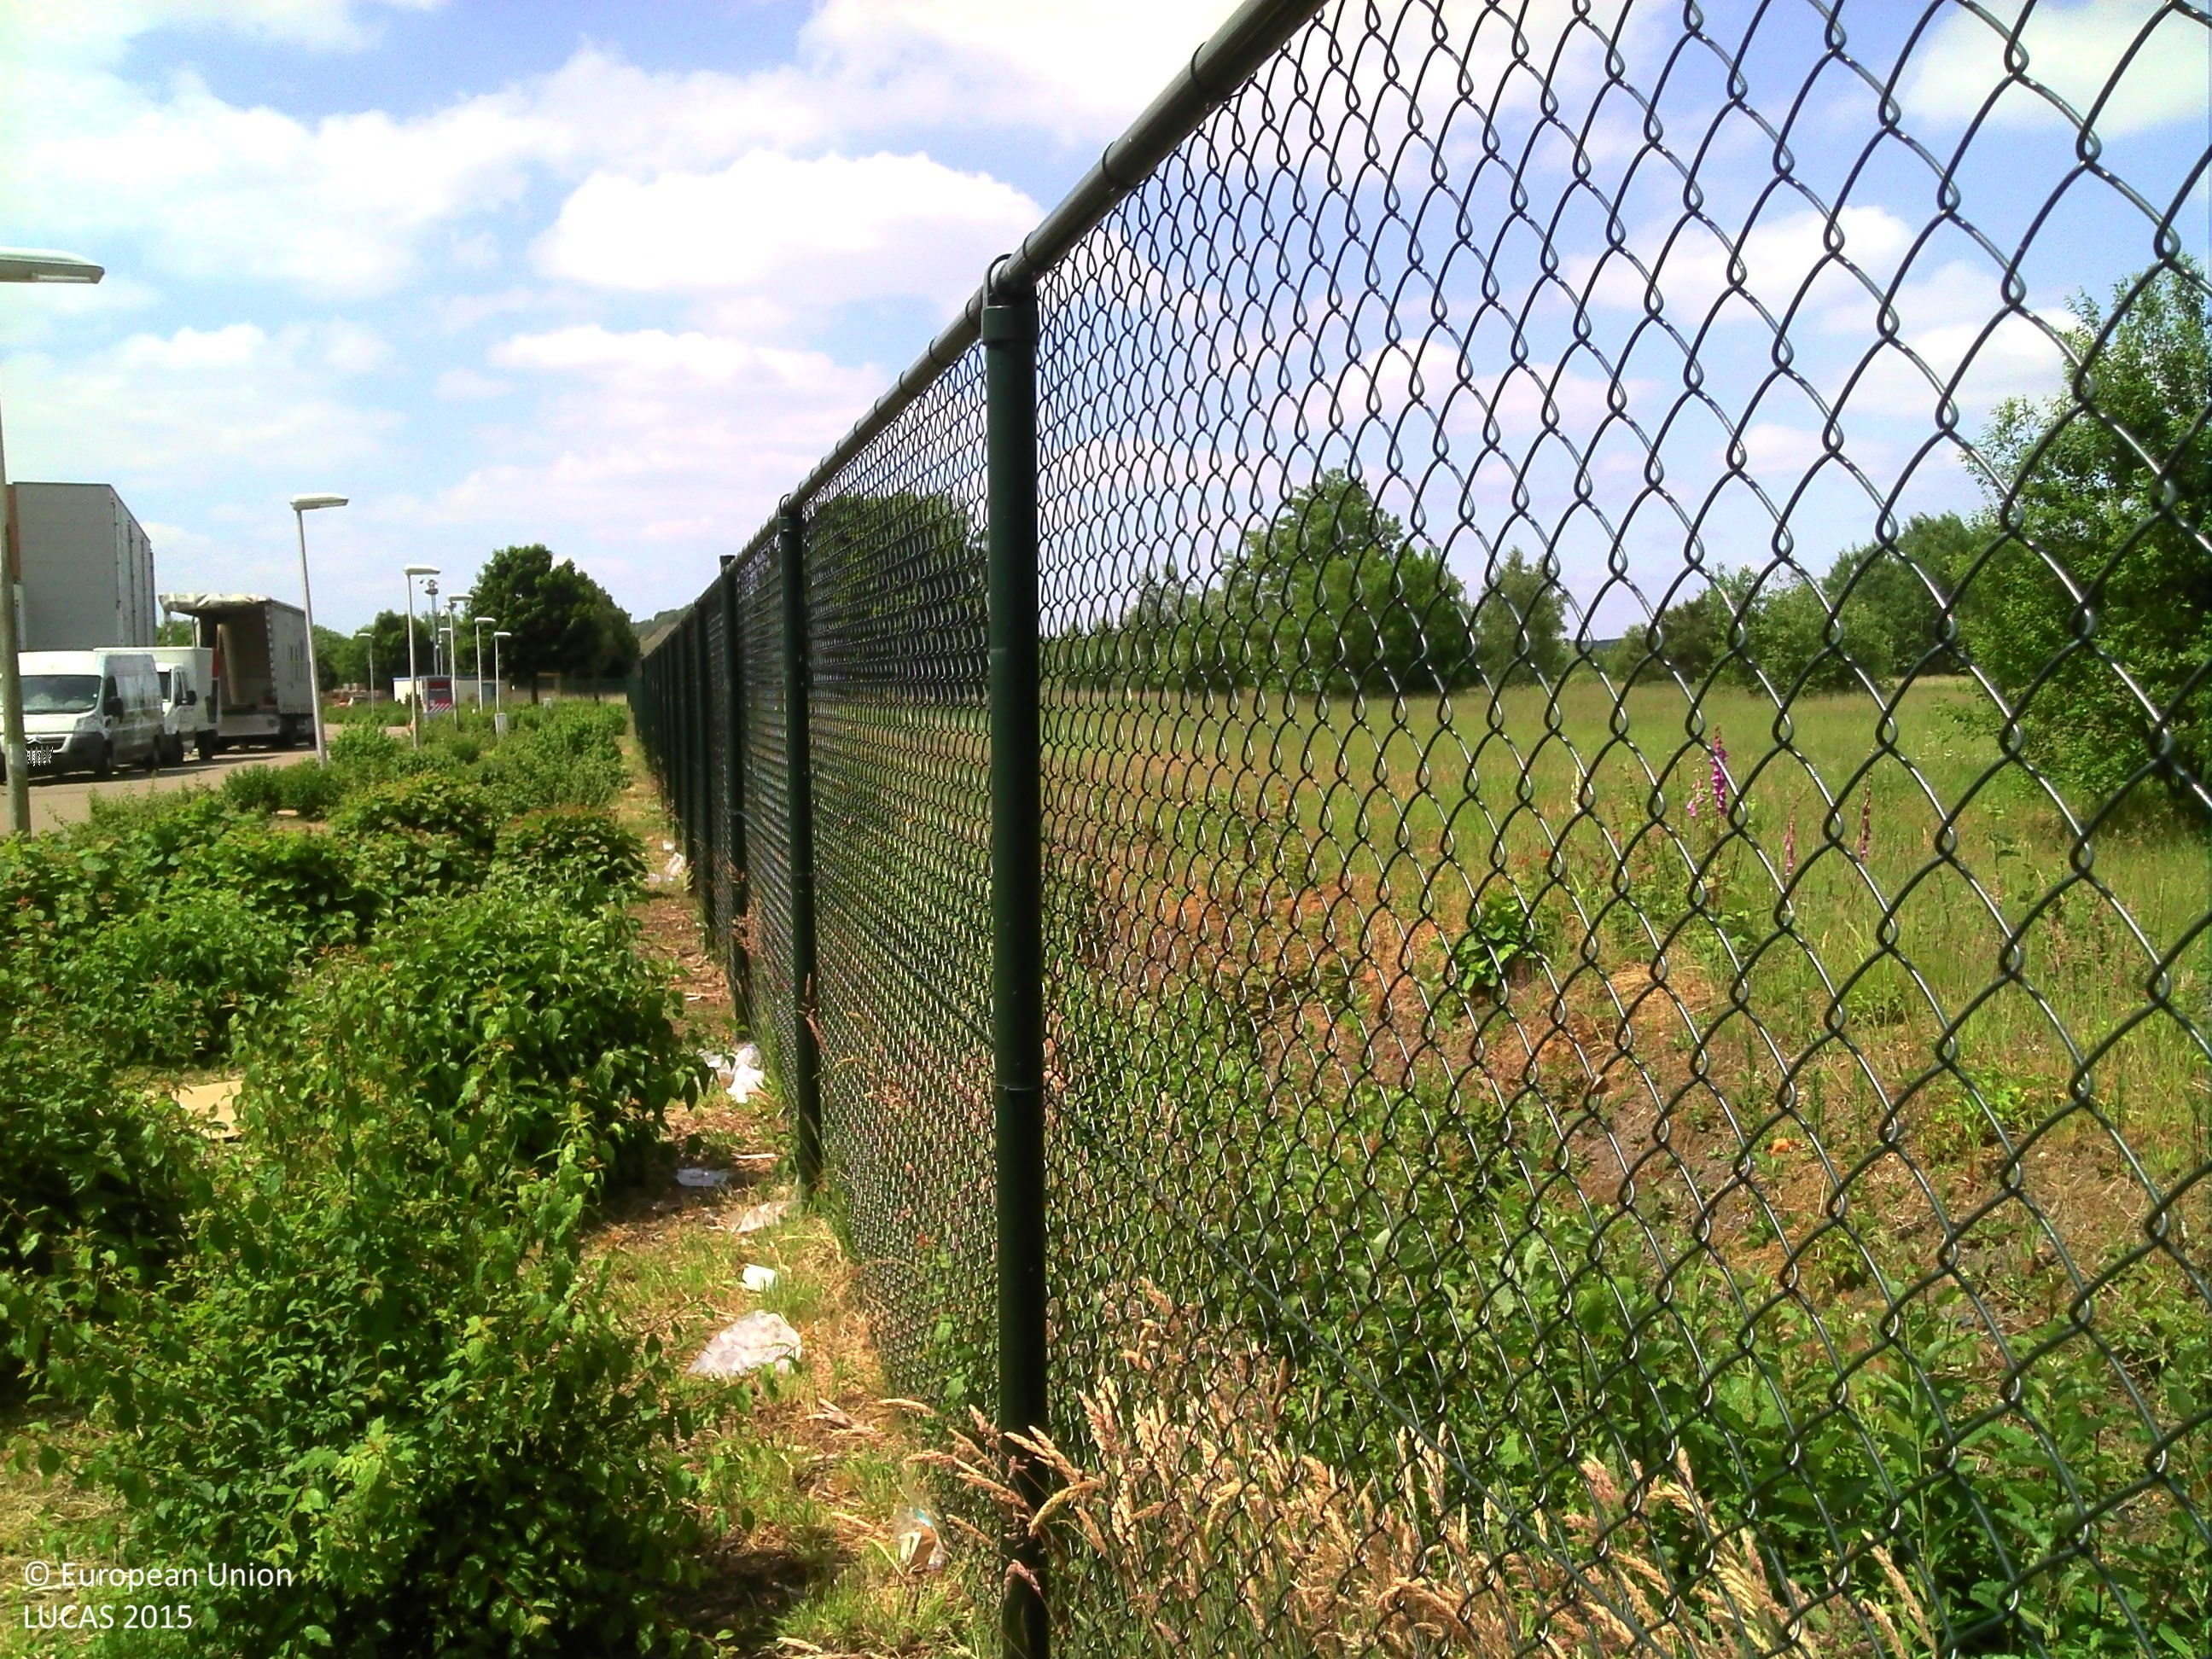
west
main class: Grassland
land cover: Grassland with sparse tree/shrub cover
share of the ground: > 75 %
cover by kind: herbaceous plants 95 %, broadleaved forest trees 5 %
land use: Semi-natural and natural areas not in use
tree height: < 5 m
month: June
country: BE
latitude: 51.0038
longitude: 5.7090
